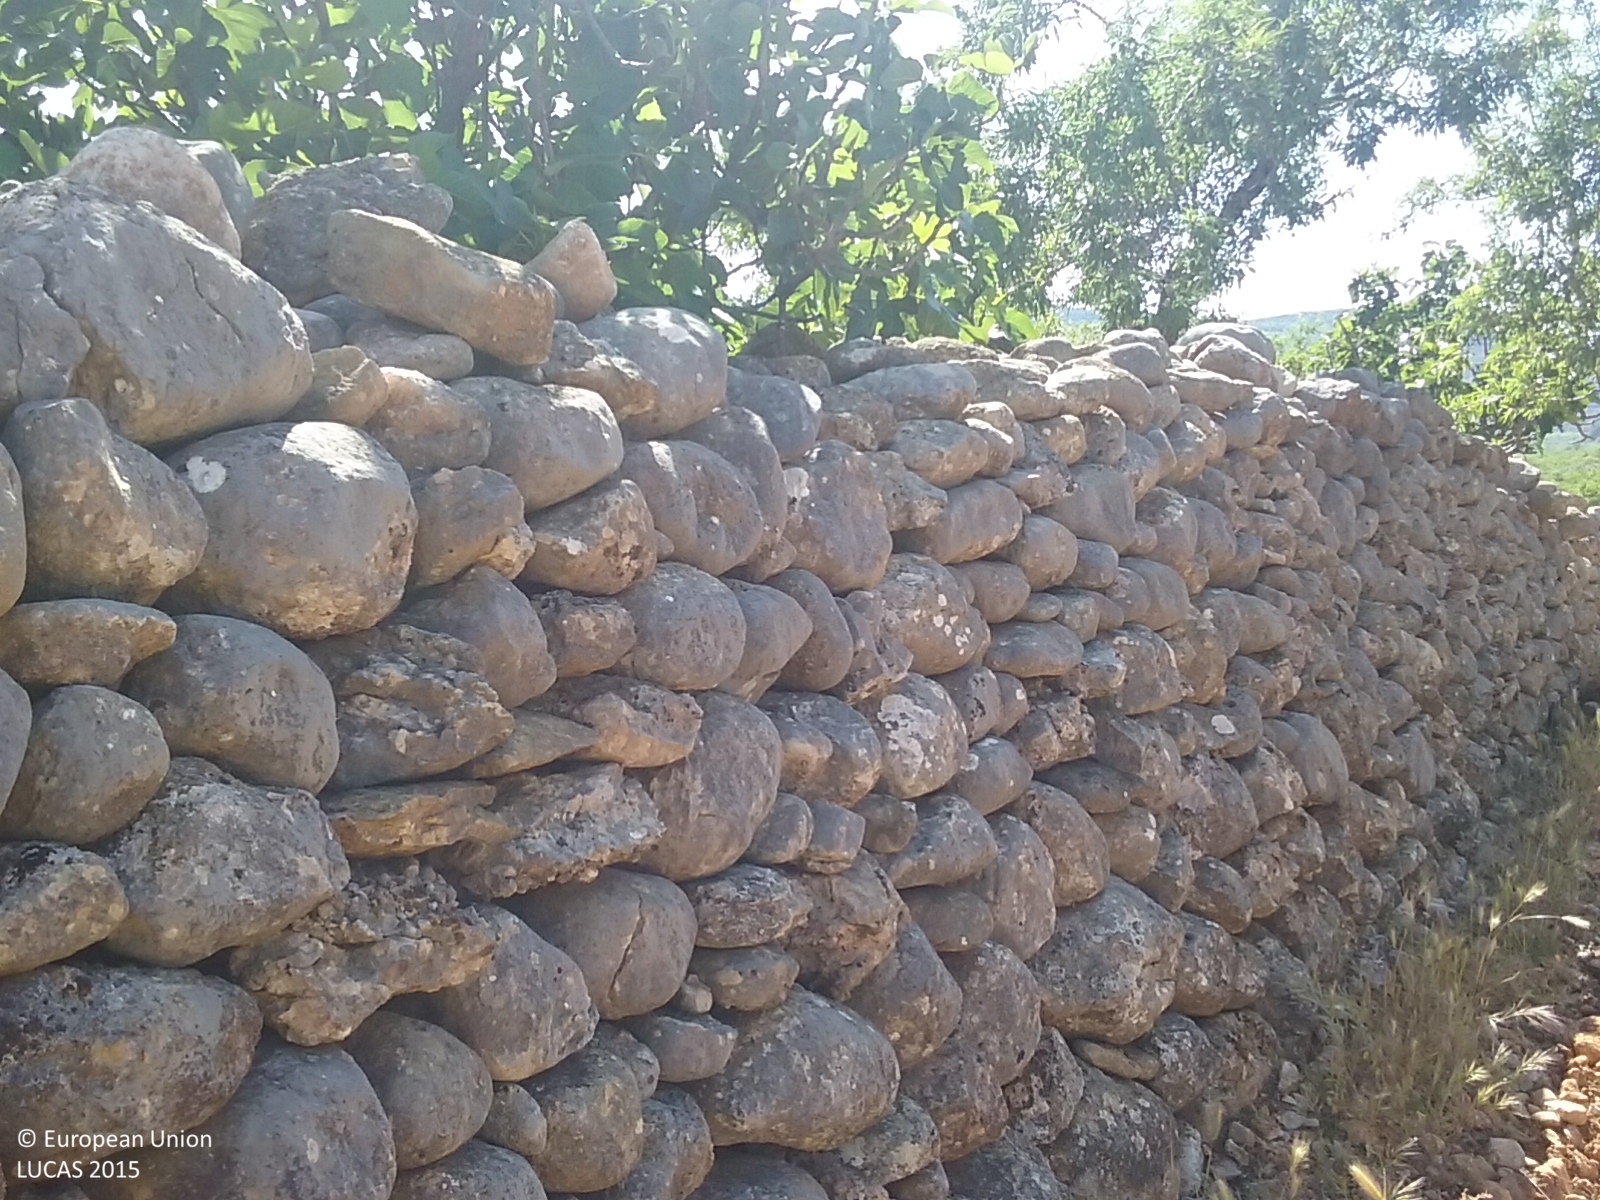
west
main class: Cropland
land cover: Nuts trees
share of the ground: 25 - 50 %
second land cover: Other bare soil
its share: > 75 %
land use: Agriculture (excluding fallow land and kitchen gardens)
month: May
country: ES
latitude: 40.3693
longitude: -0.0505
